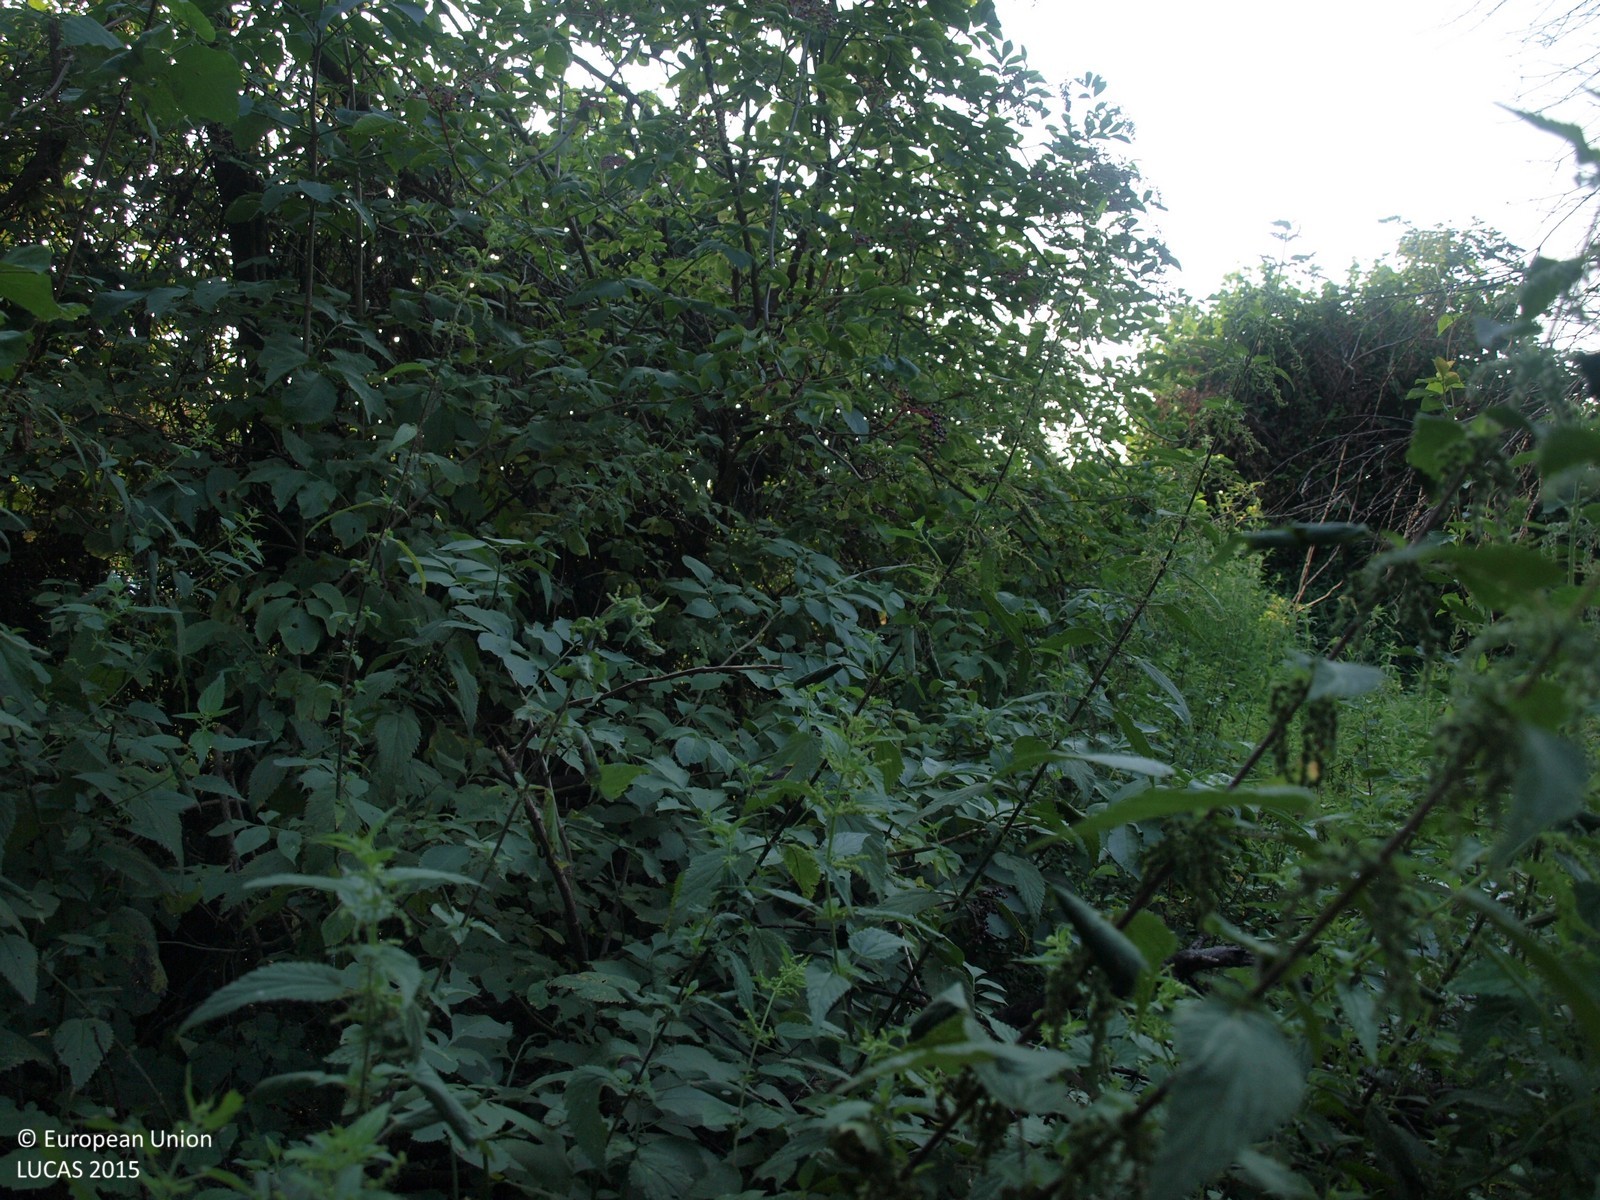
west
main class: Shrubland
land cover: Shrubland with sparse tree cover
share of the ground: > 75 %
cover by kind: shrubs 95 %, broadleaved forest trees 5 %
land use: Semi-natural and natural areas not in use
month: August
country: HR
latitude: 45.9692
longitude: 16.2580
